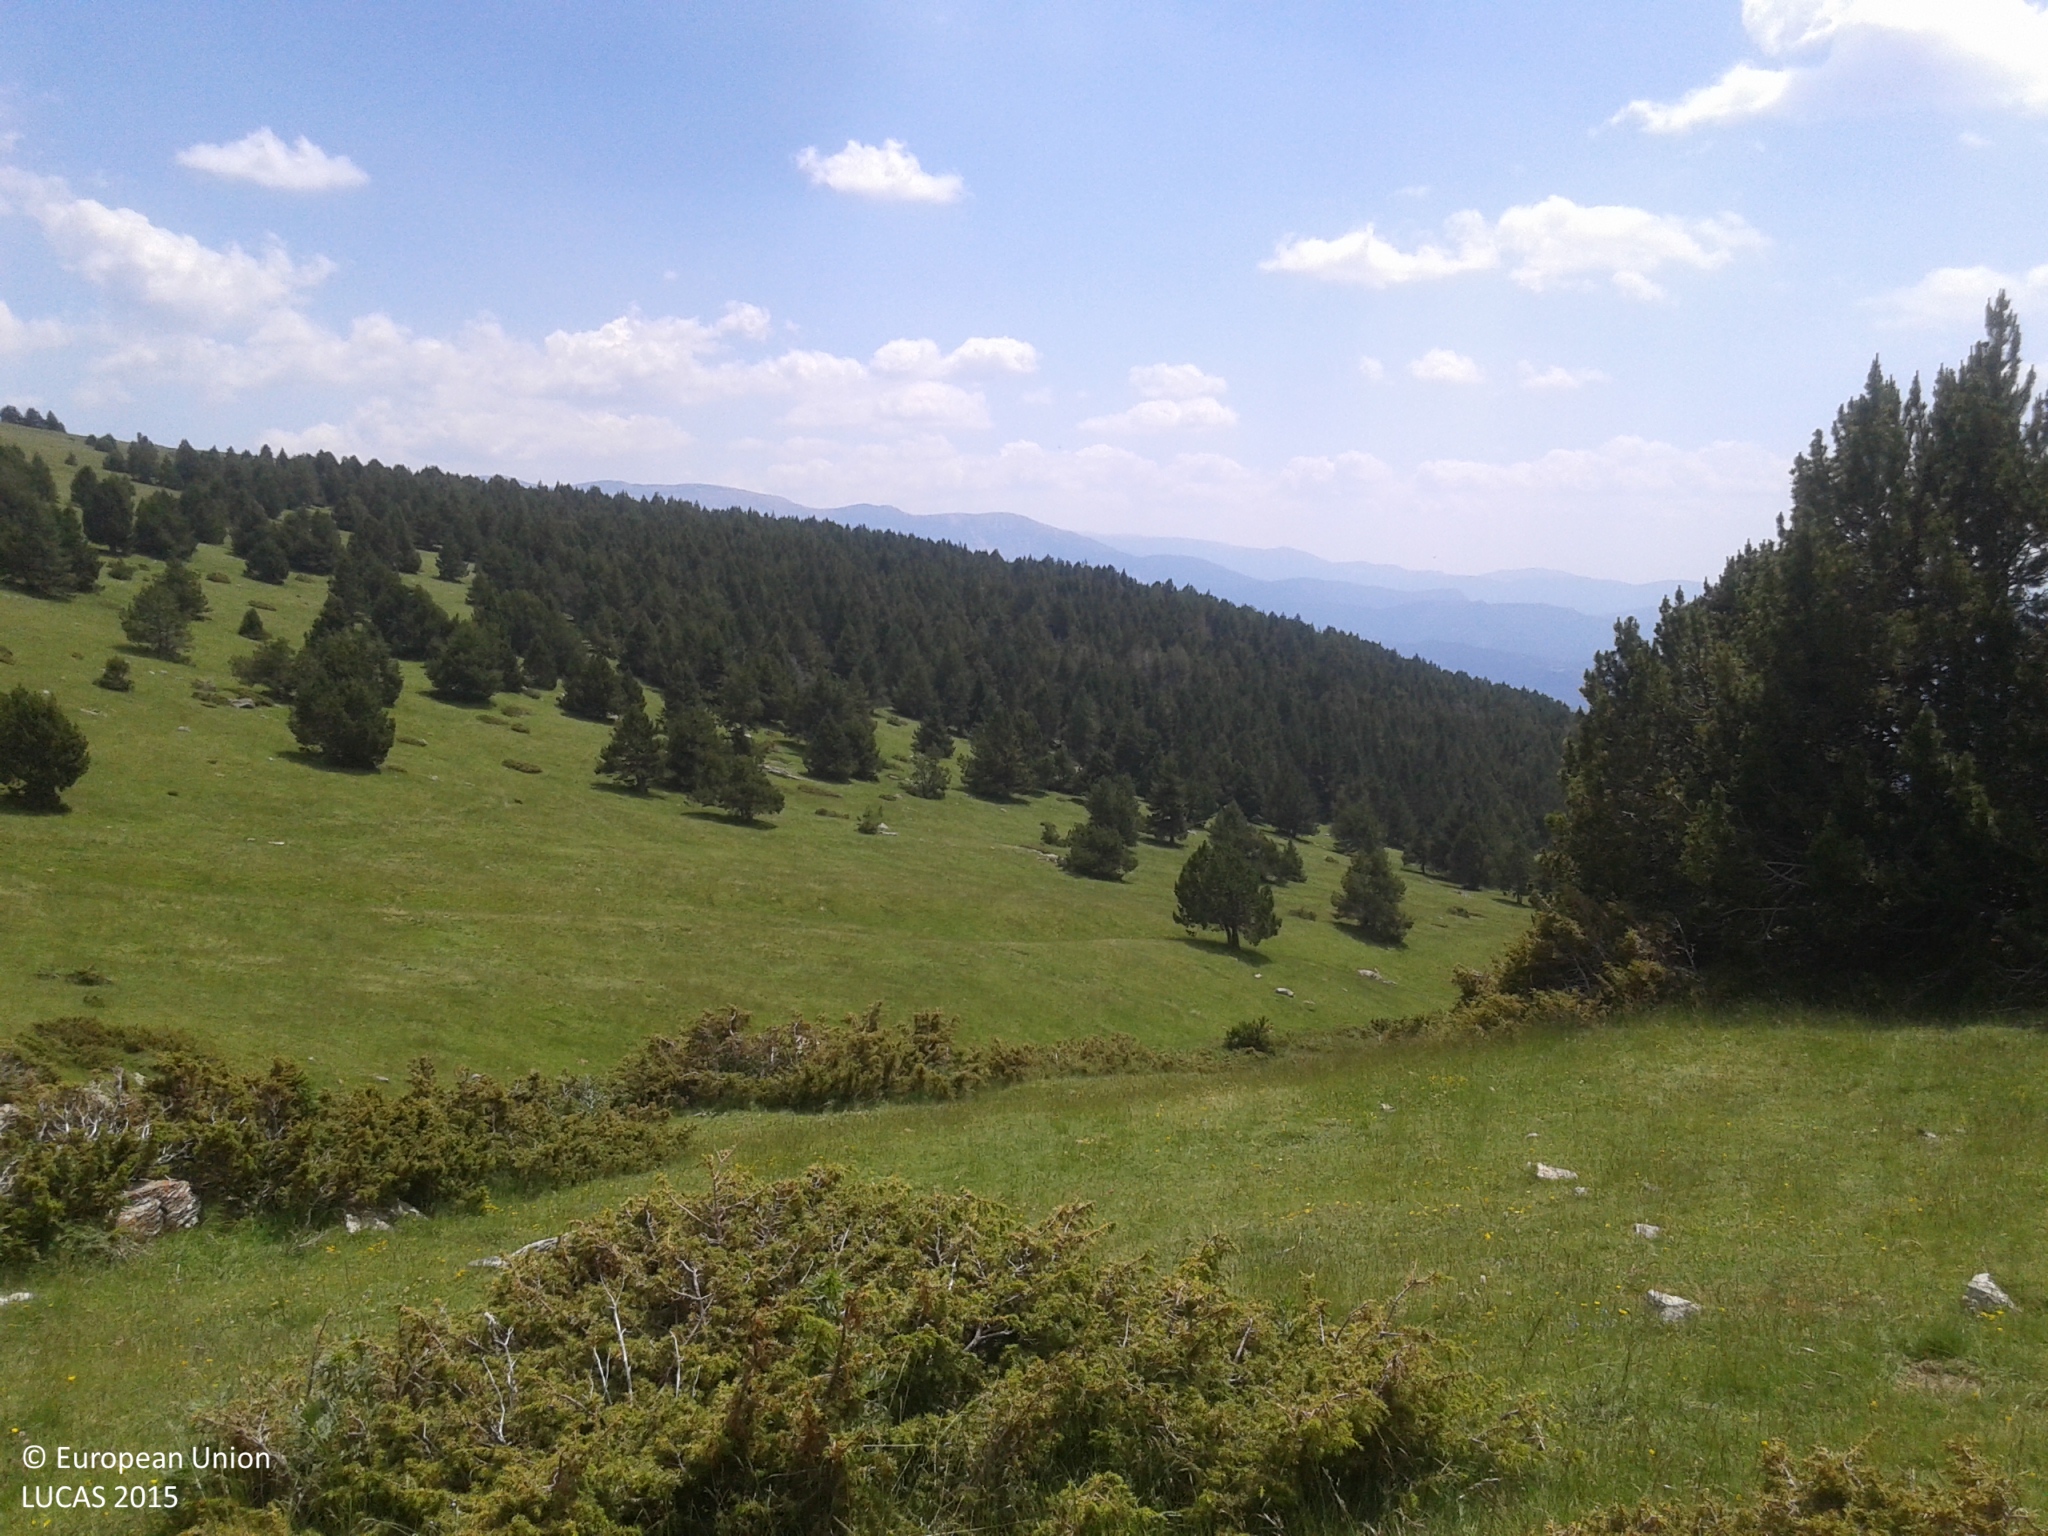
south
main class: Shrubland
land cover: Shrubland with sparse tree cover
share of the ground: > 75 %
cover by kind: herbaceous plants 85 %, shrubs 10 %, coniferous forest trees 5 %
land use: Agriculture (excluding fallow land and kitchen gardens)
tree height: > 5 m
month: June
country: ES
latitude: 42.4126
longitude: 1.5891
